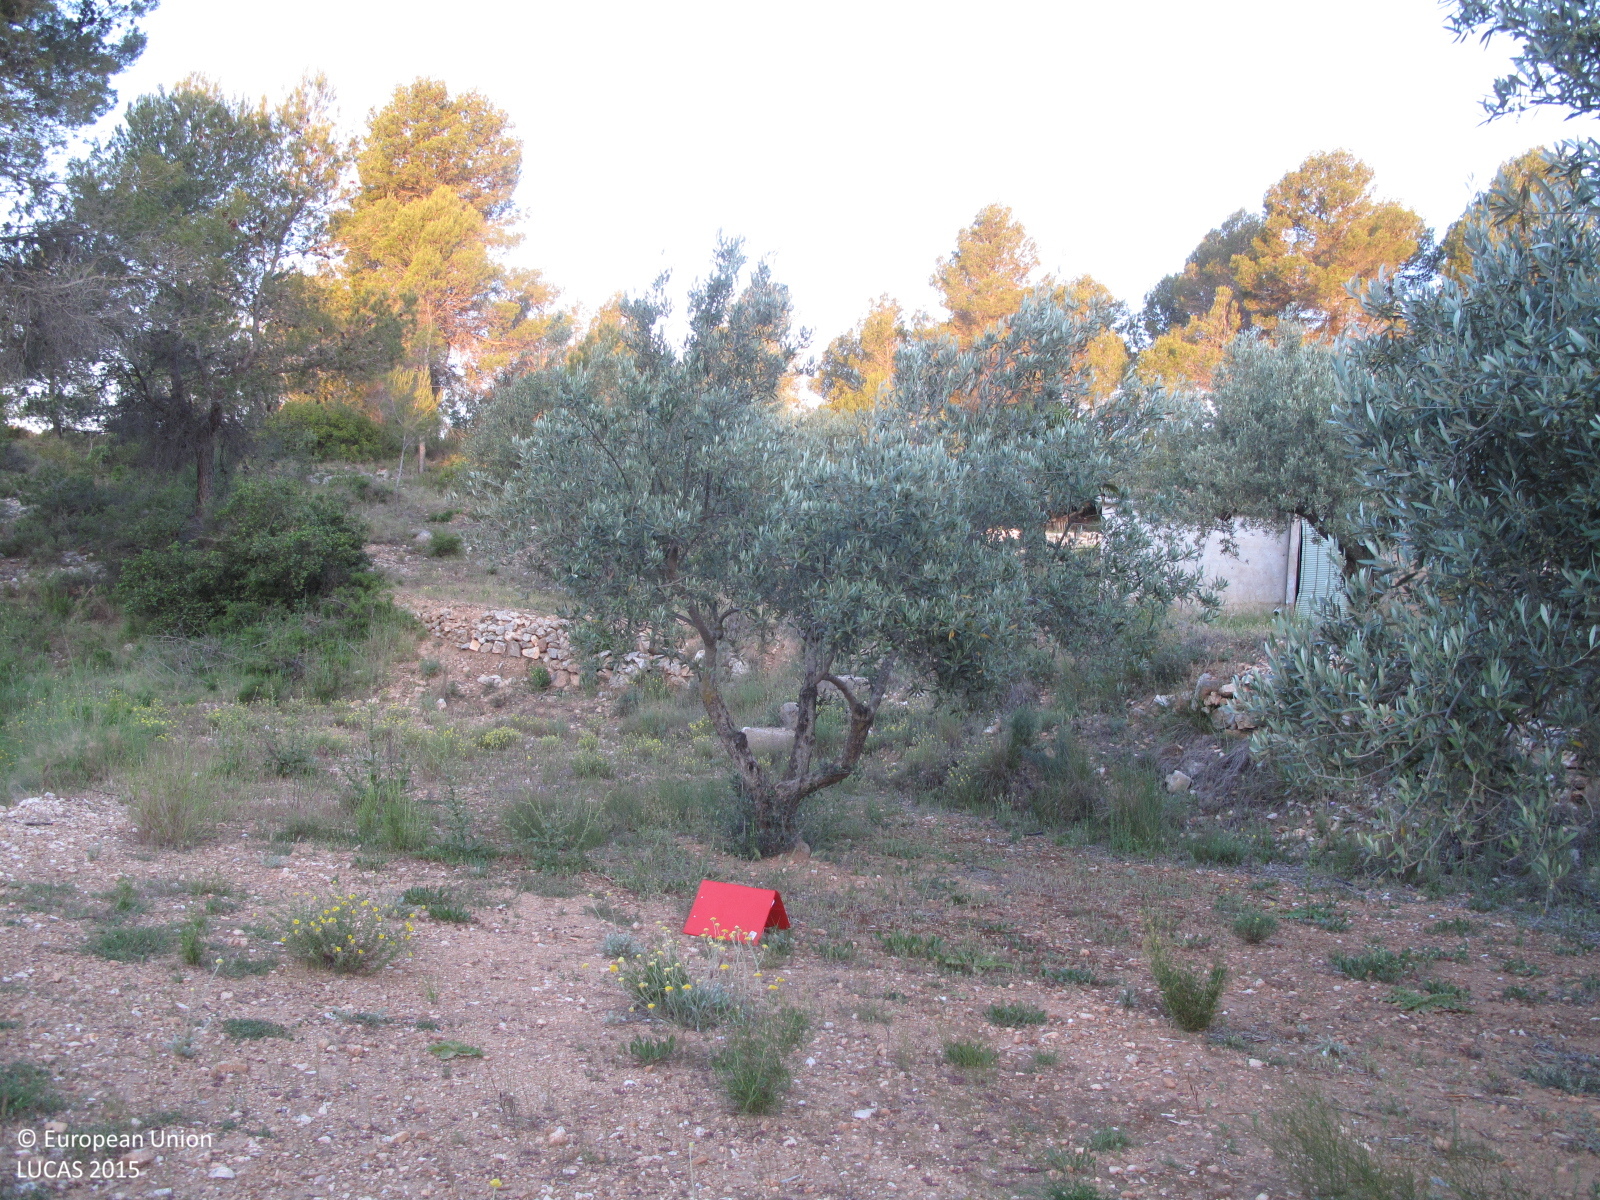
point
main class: Cropland
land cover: Olive groves
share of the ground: 25 - 50 %
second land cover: Spontaneously vegetated surfaces
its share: 25 - 50 %
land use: Agriculture (excluding fallow land and kitchen gardens)
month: May
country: ES
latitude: 38.8878
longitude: -0.7719
